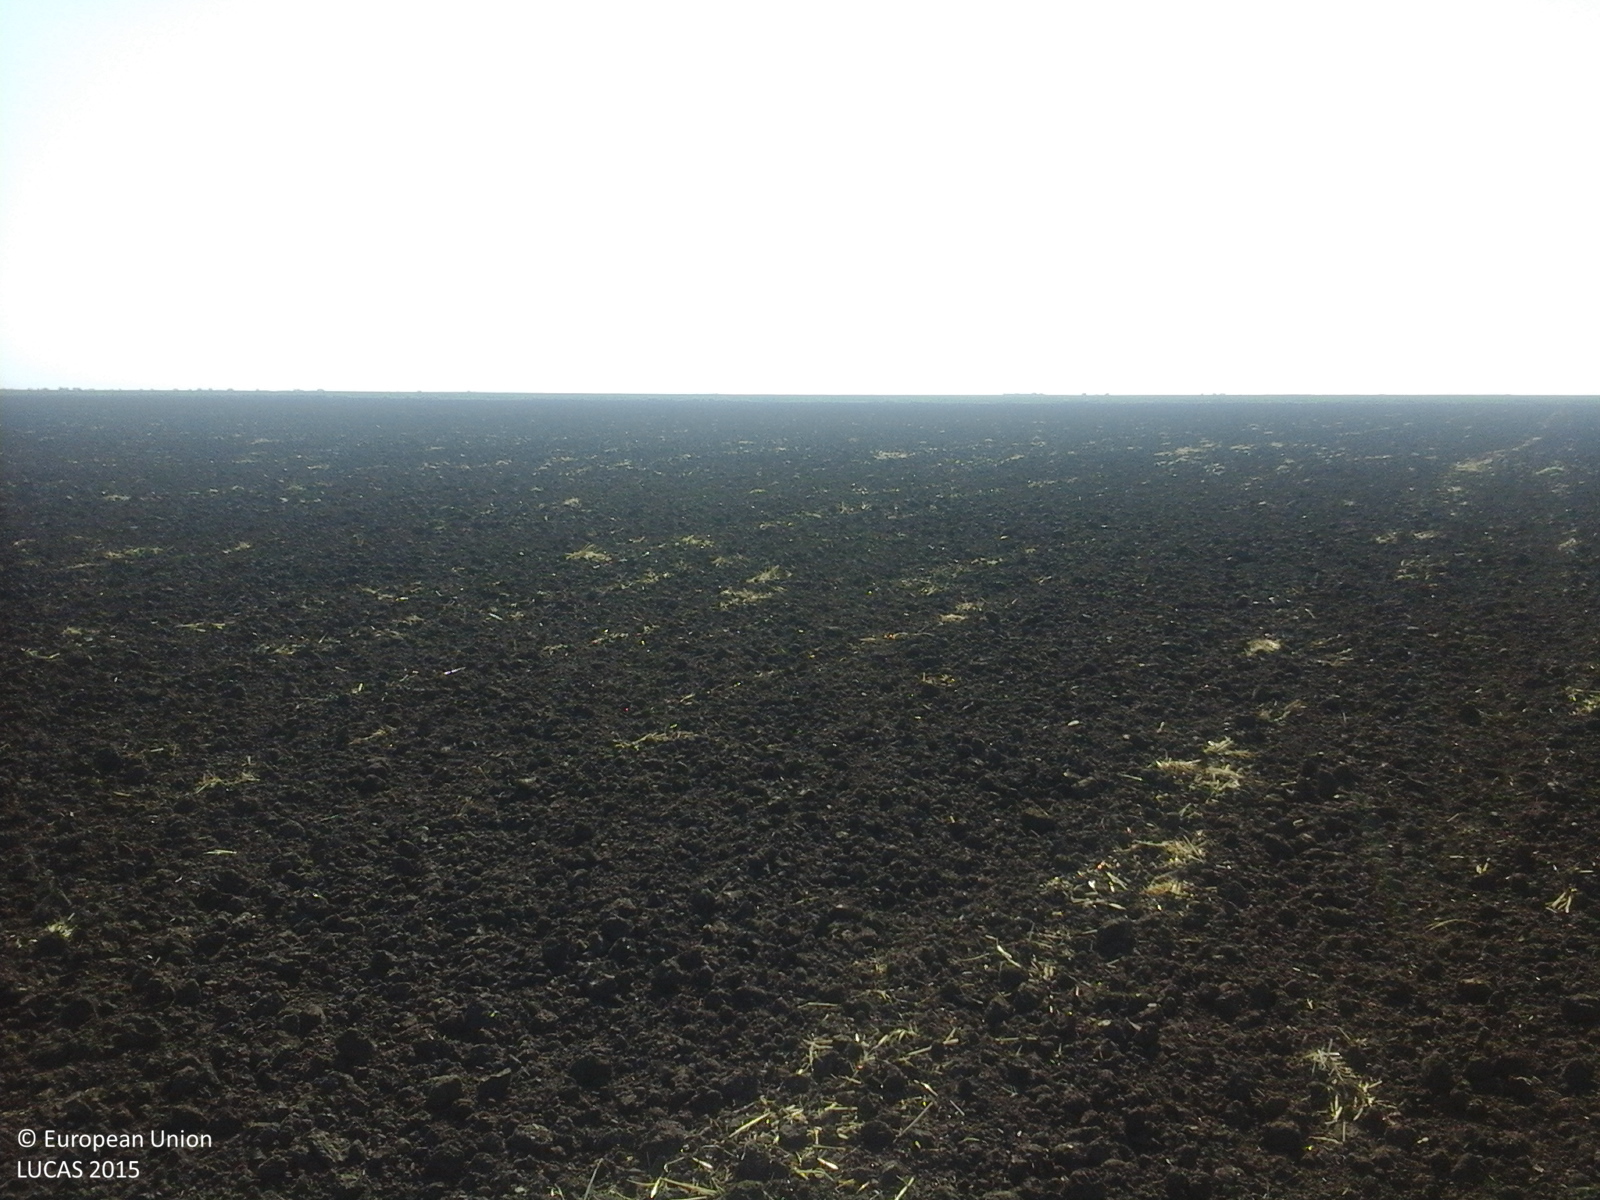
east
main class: Cropland
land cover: Durum wheat
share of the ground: < 10 %
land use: Agriculture (excluding fallow land and kitchen gardens)
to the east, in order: Durum wheat
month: July
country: RO
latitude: 44.3408
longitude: 27.1778
